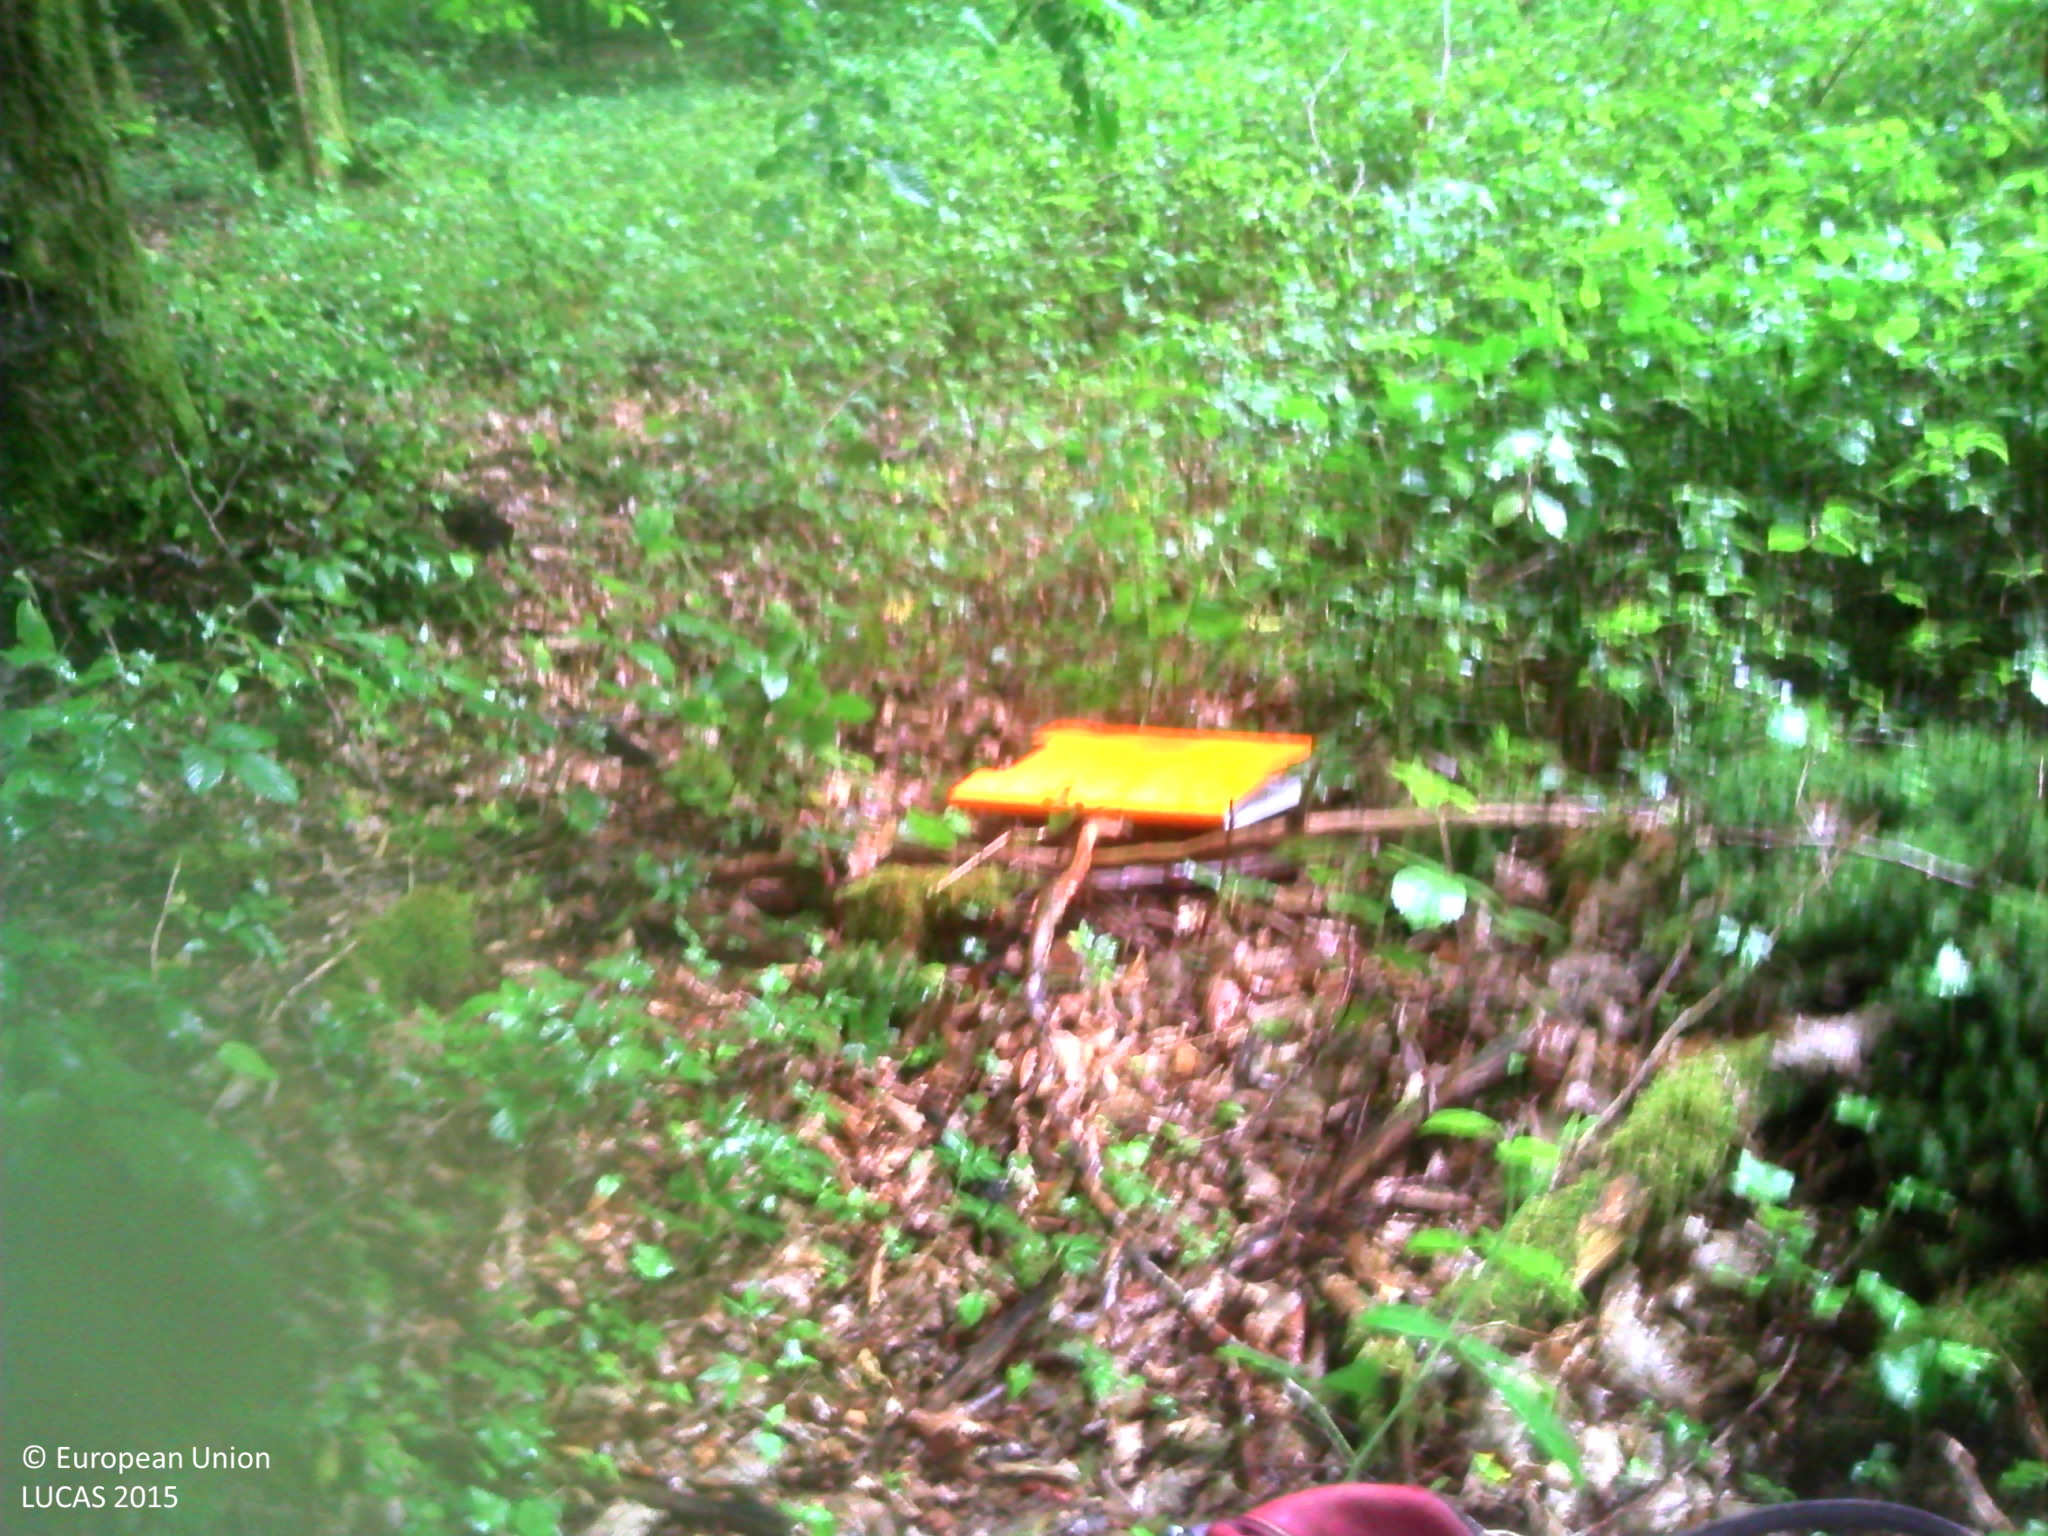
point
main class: Woodland
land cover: Broadleaved woodland
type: mesophytic deciduous forest
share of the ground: > 75 %
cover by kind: broadleaved forest trees 90 %, herbaceous plants 10 %
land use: Forestry
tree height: > 5 m
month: May
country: FR
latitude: 48.6121
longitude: 4.9389
